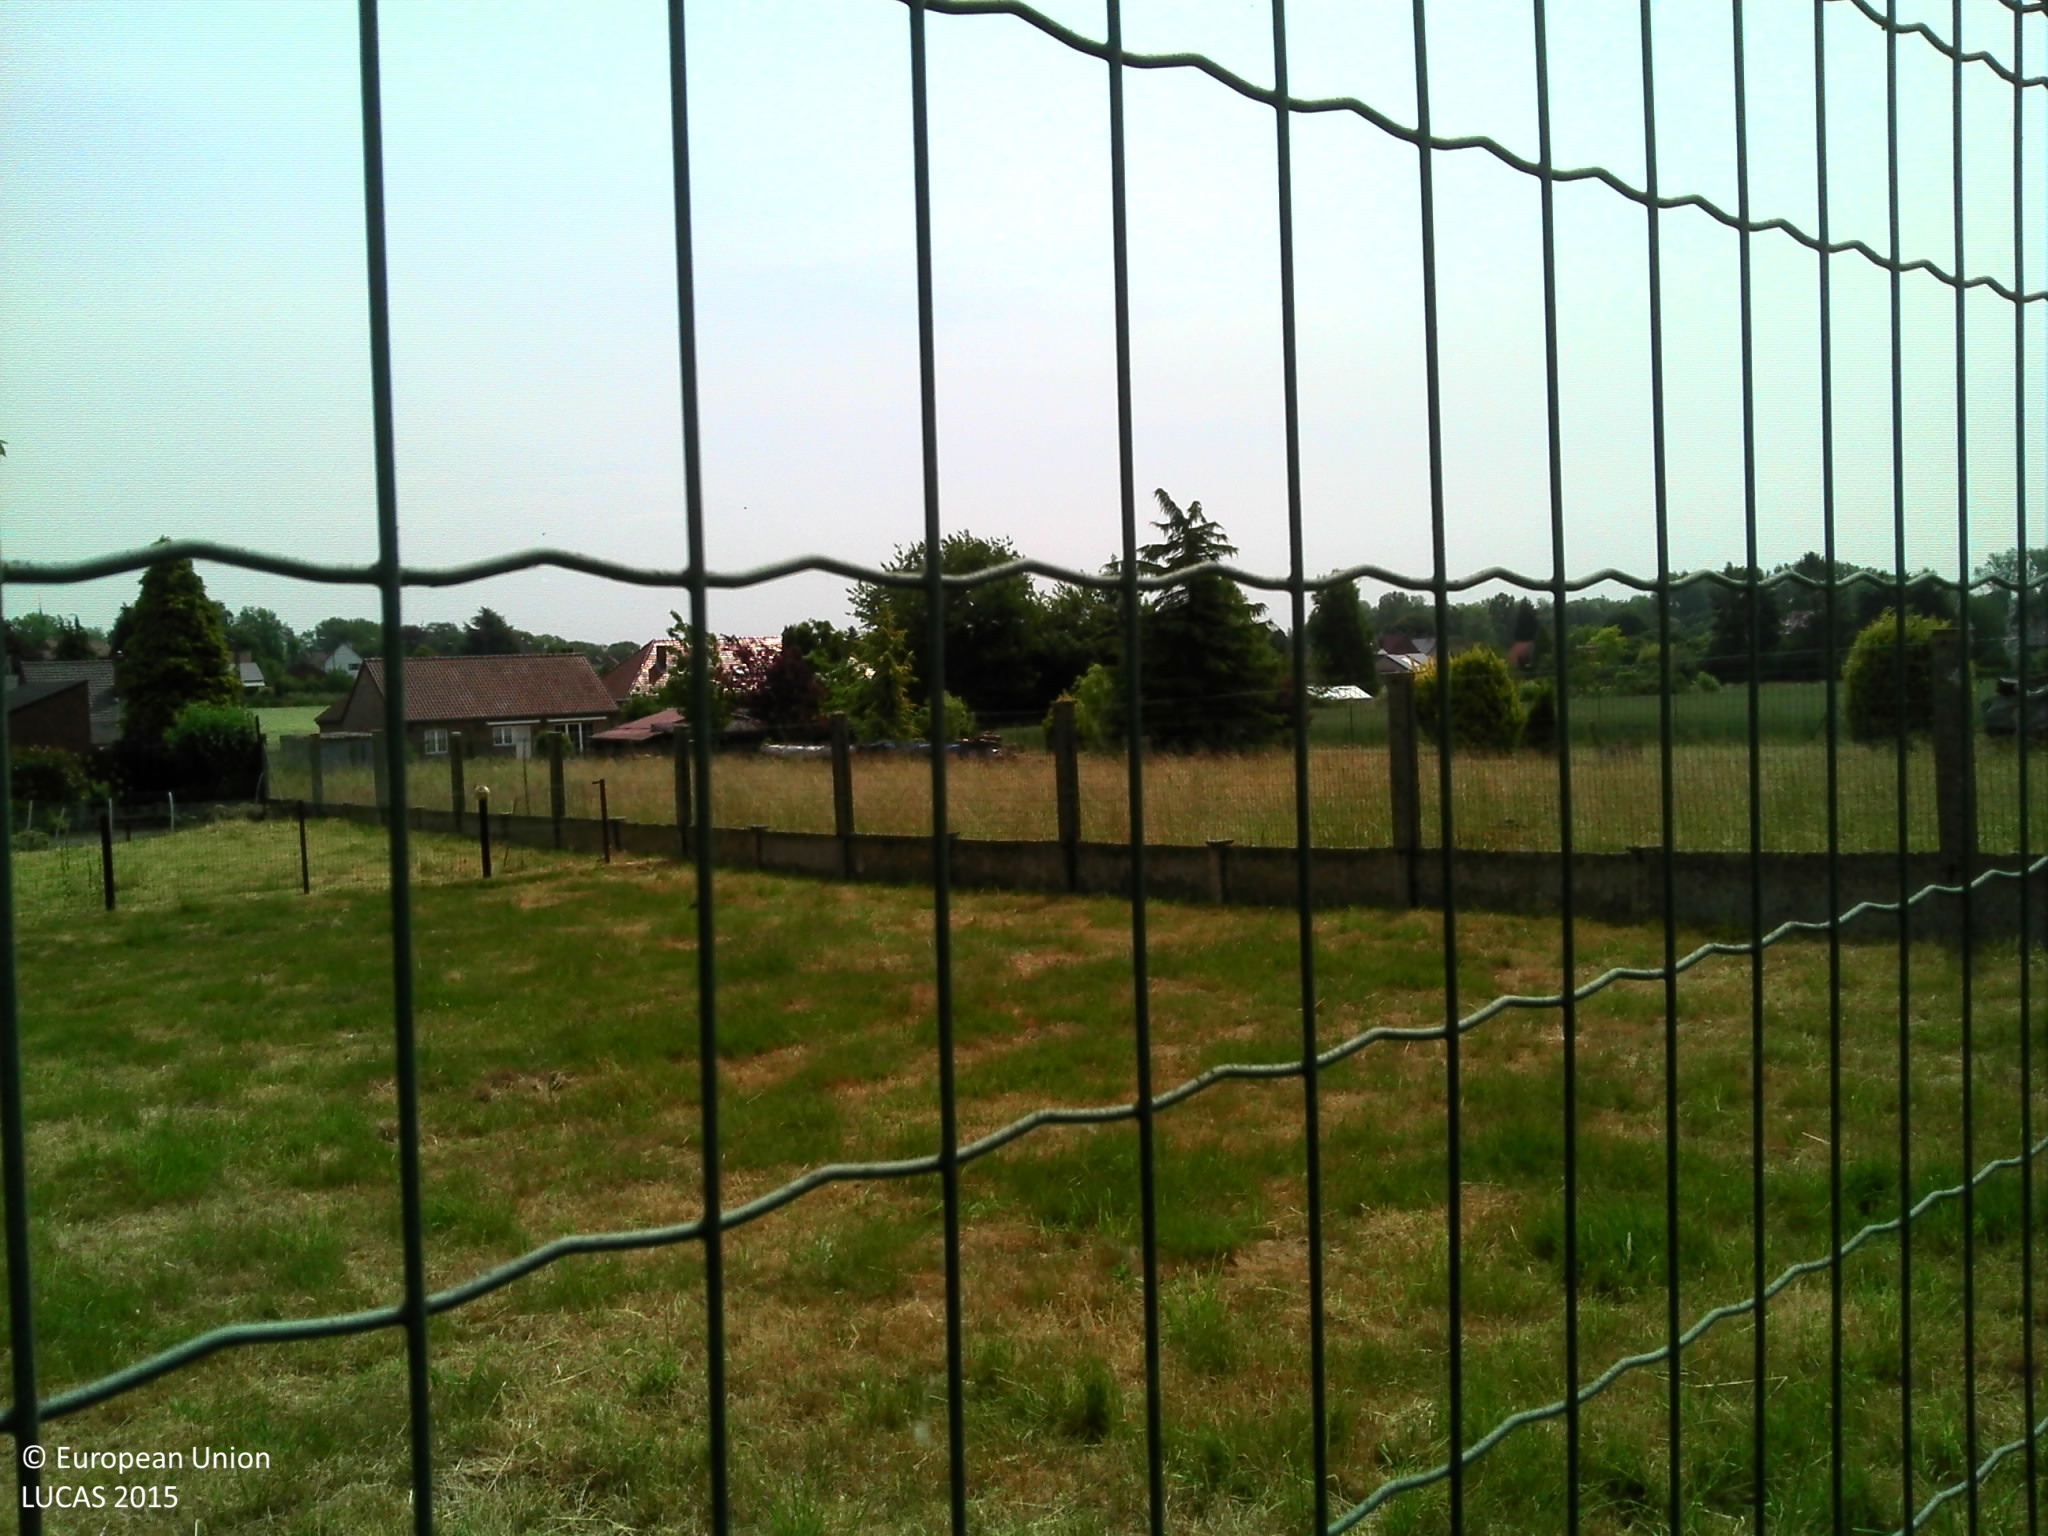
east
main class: Grassland
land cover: Grassland with sparse tree/shrub cover
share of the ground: > 75 %
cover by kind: herbaceous plants 95 %, broadleaved forest trees 5 %
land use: Residential
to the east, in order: Grassland with sparse tree/shrub cover; Artificial constructions in urban areas; Temporary grasslands
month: June
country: BE
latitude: 50.4817
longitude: 3.7502
